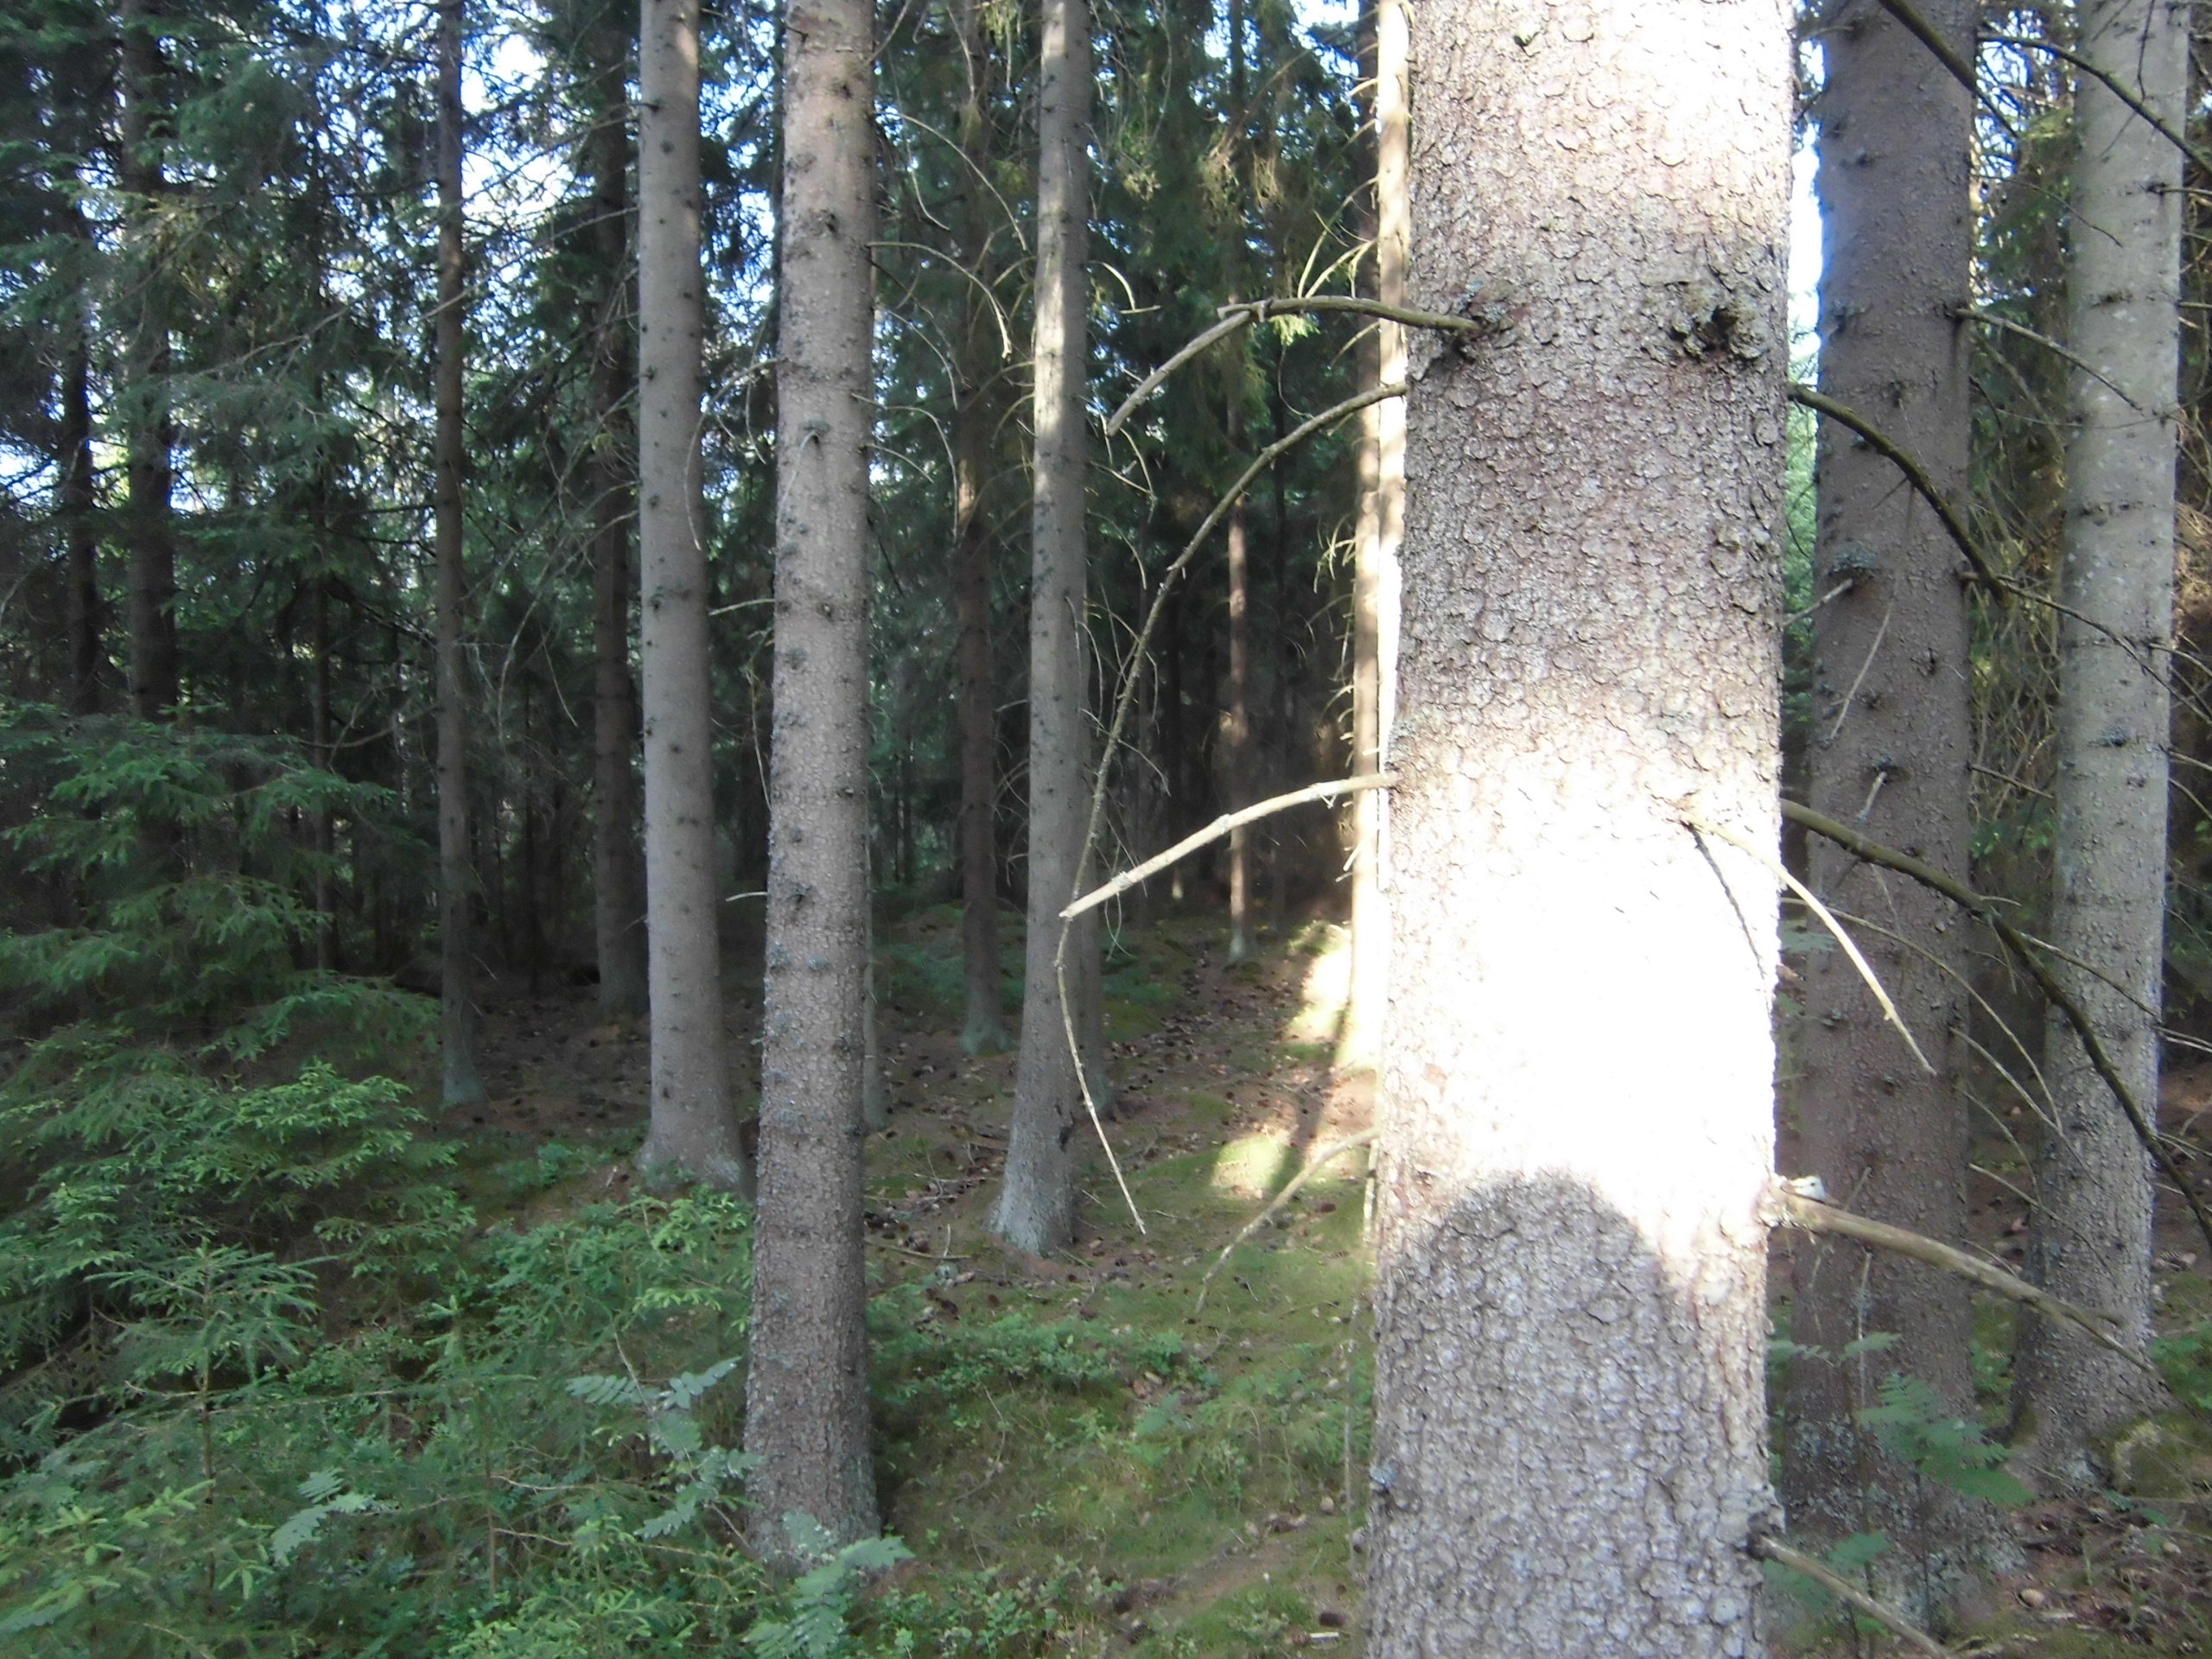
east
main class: Woodland
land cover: Spruce dominated coniferous woodland
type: boreal forest
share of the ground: > 75 %
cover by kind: coniferous forest trees 75 %, lichens and mosses 10 %, broadleaved forest trees 5 %, shrubs 5 %, unconsolidated bare surface 5 %
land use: Forestry
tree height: > 5 m
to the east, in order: Spruce dominated coniferous woodland; Pine dominated coniferous woodland; Inland fresh water bodies
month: July
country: SE
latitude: 57.3614
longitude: 14.7340
